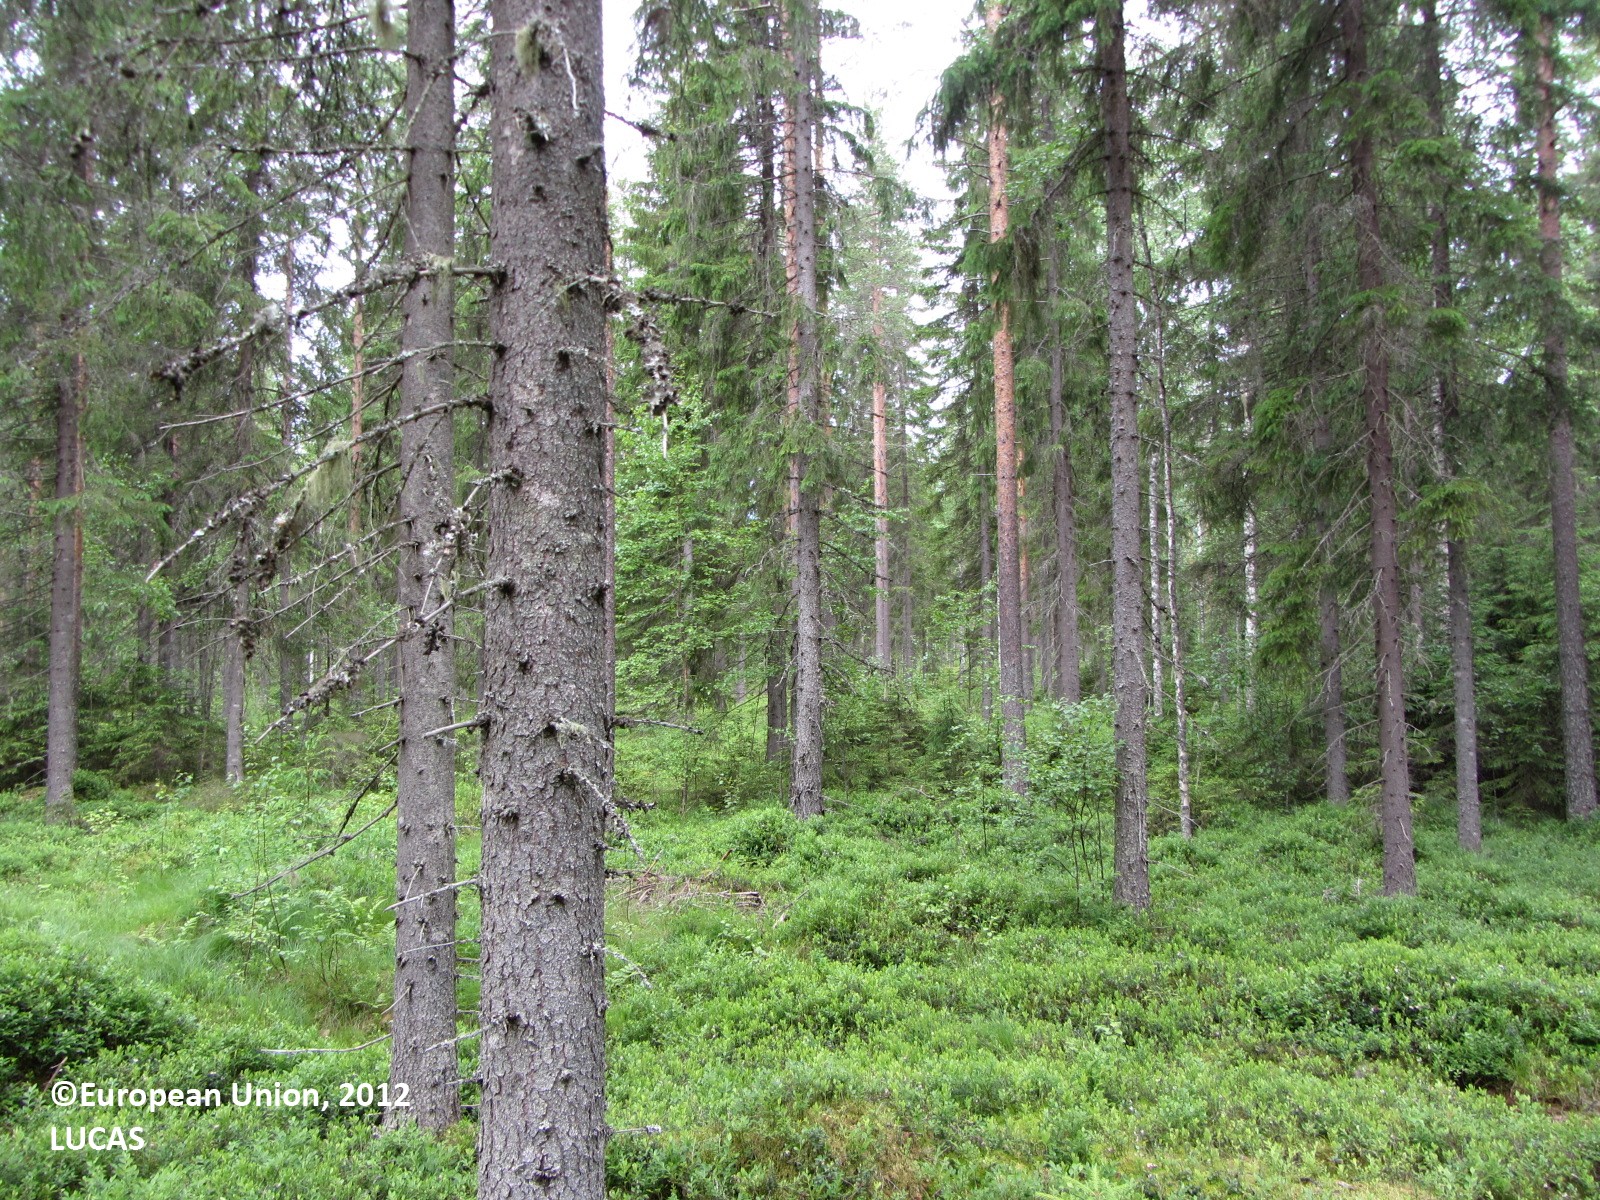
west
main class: Woodland
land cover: Spruce dominated mixed woodland
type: boreal forest
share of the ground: 50 - 75 %
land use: Forestry
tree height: > 5 m
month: June
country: FI
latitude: 62.5864
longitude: 25.2320
